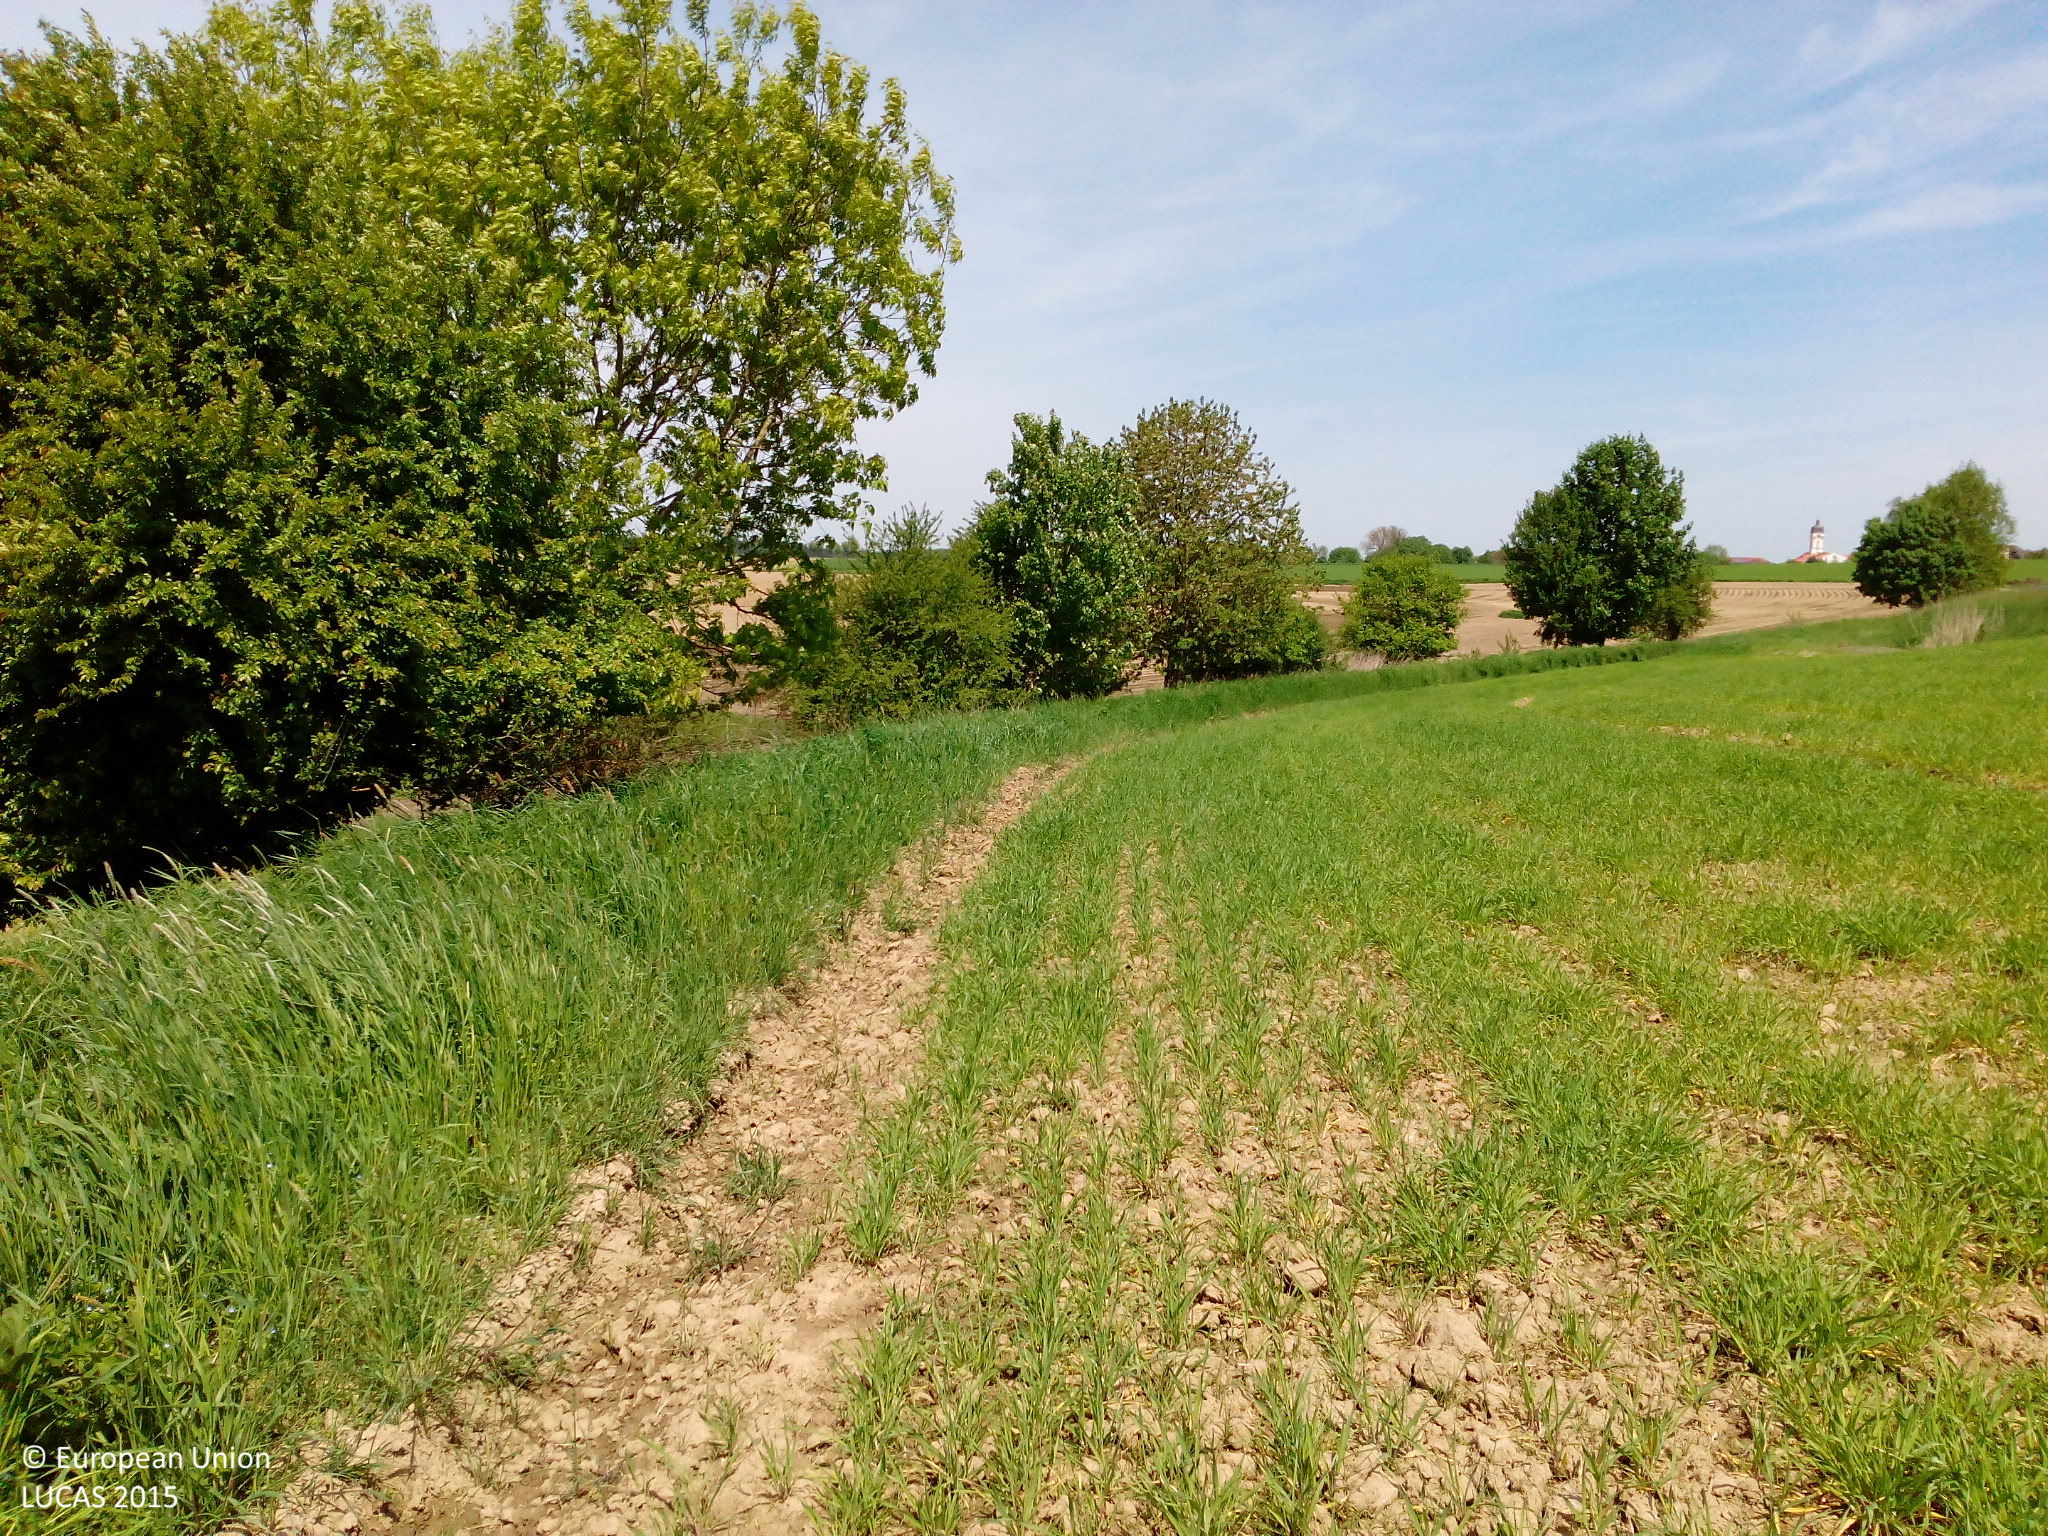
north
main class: Cropland
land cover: Barley
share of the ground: > 75 %
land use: Agriculture (excluding fallow land and kitchen gardens)
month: May
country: DE
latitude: 48.3217
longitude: 11.4693
